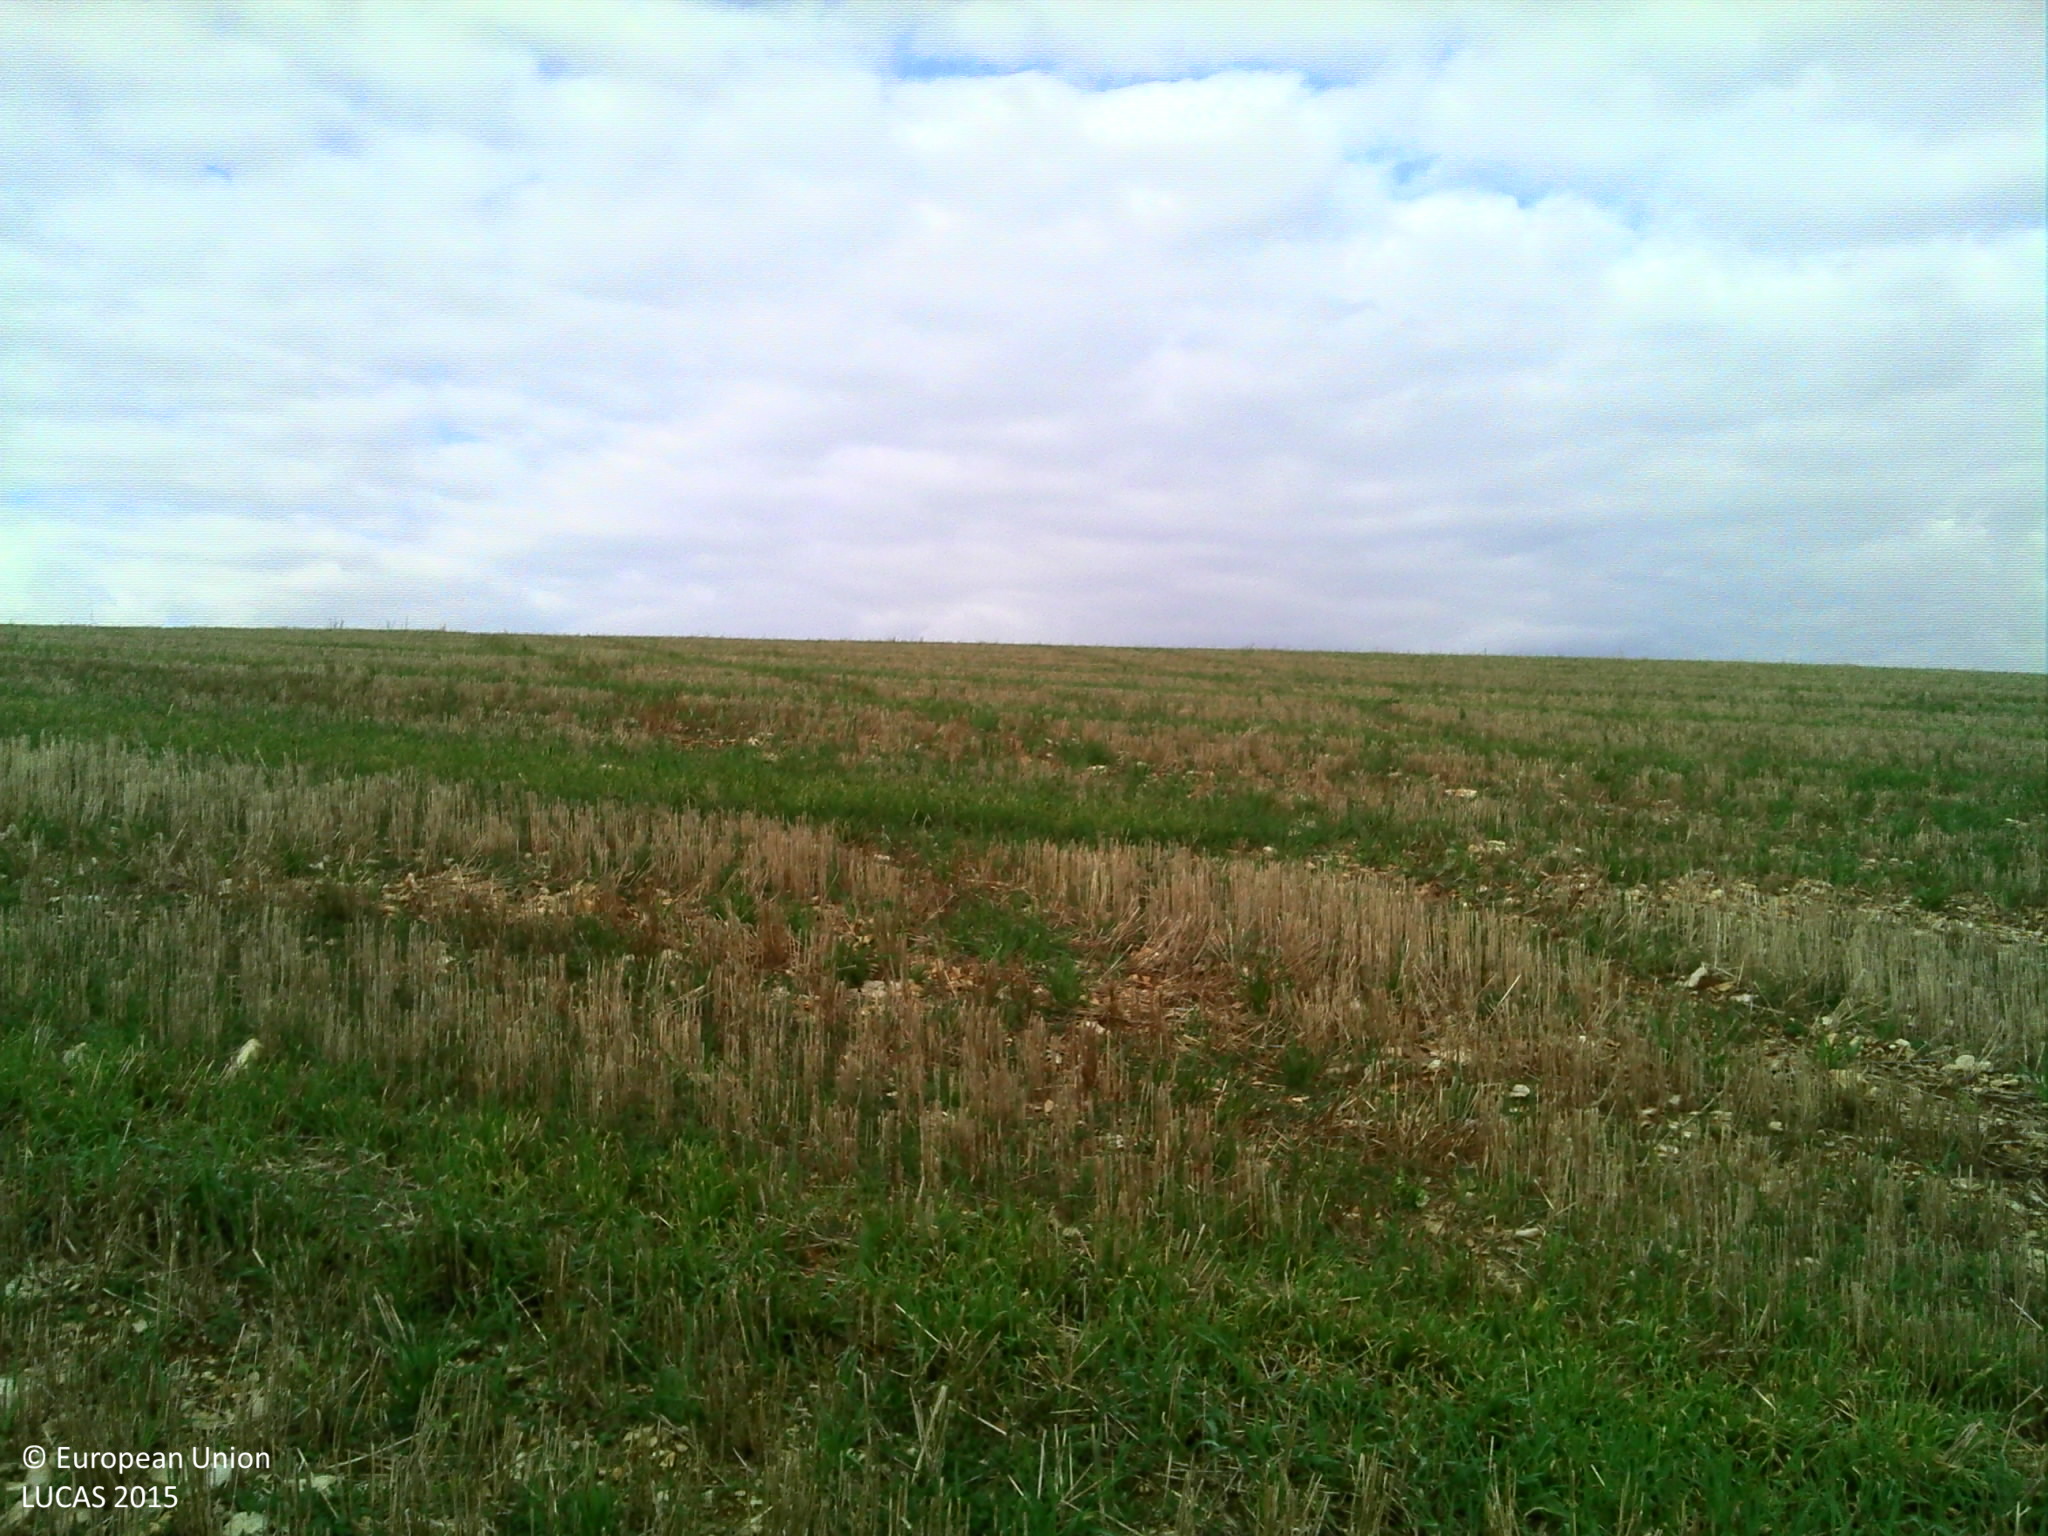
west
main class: Cropland
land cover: Barley
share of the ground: > 75 %
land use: Agriculture (excluding fallow land and kitchen gardens)
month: September
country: FR
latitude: 47.6613
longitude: 4.6594
